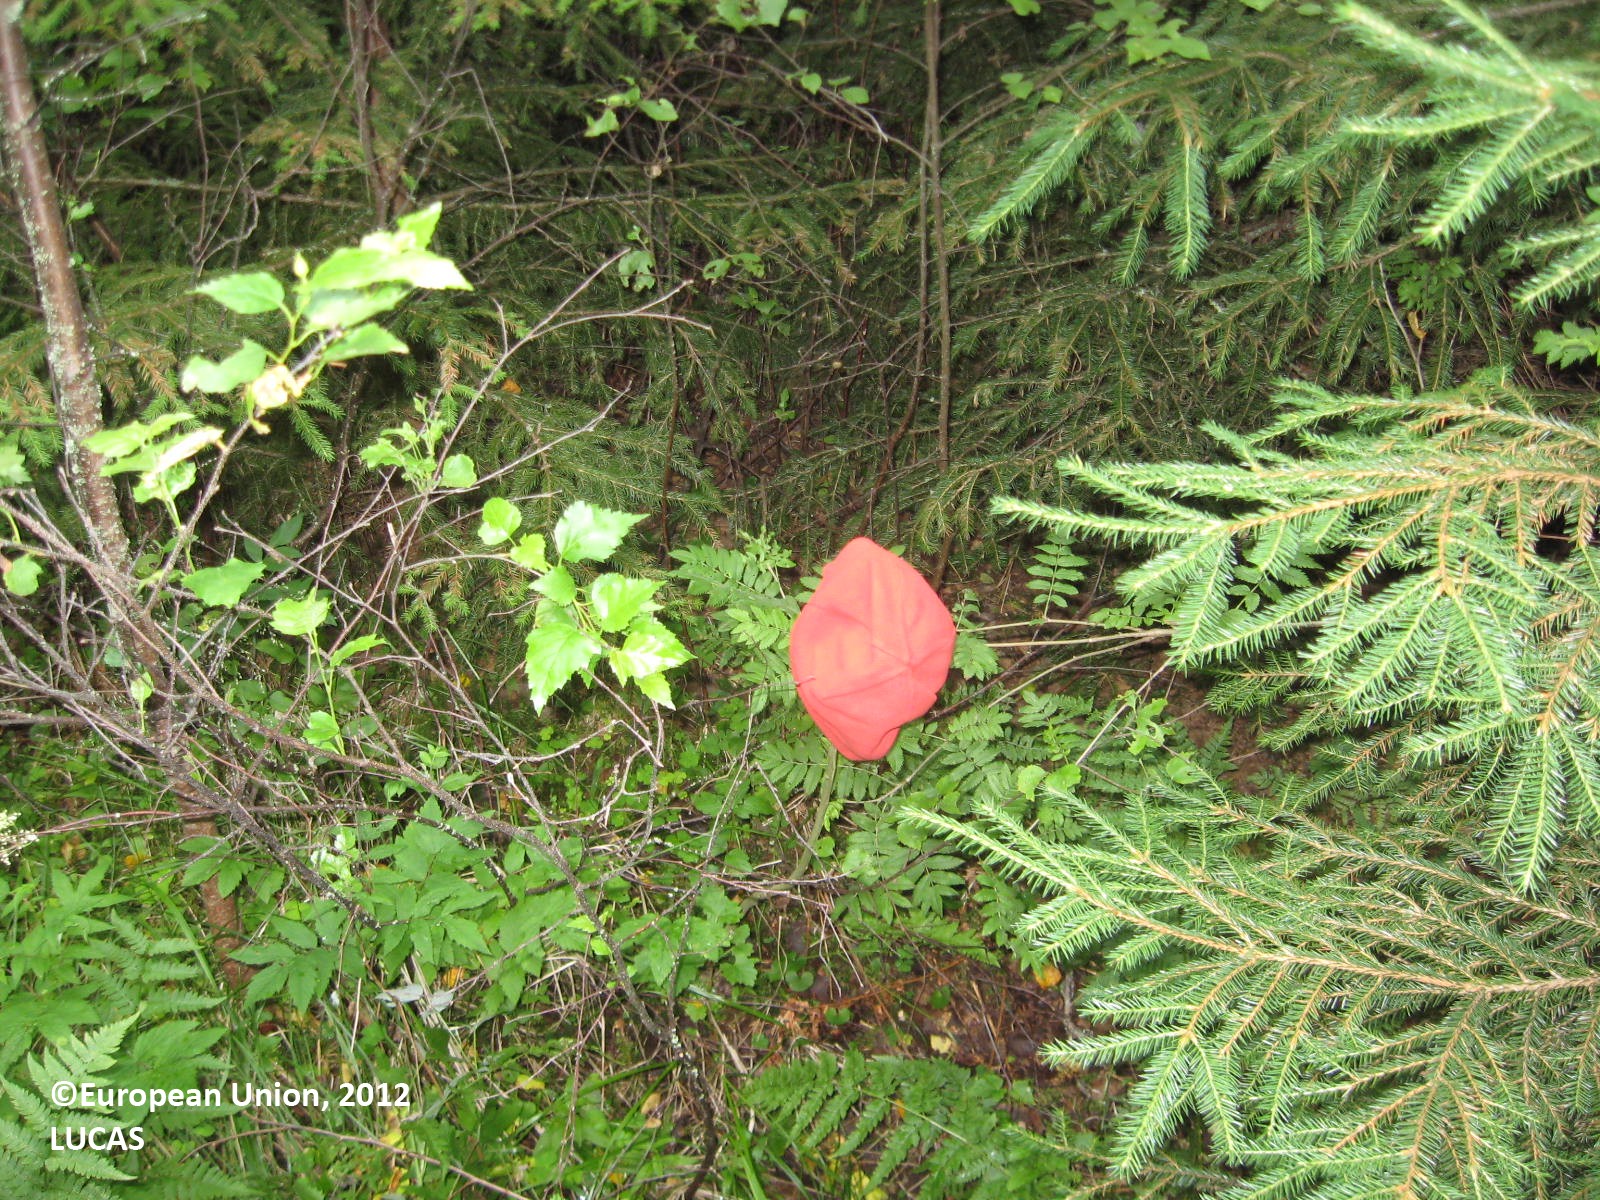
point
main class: Woodland
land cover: Other mixed woodland
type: boreal forest
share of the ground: > 75 %
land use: Forestry
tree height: > 5 m
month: July
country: FI
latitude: 61.8387
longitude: 21.5396
